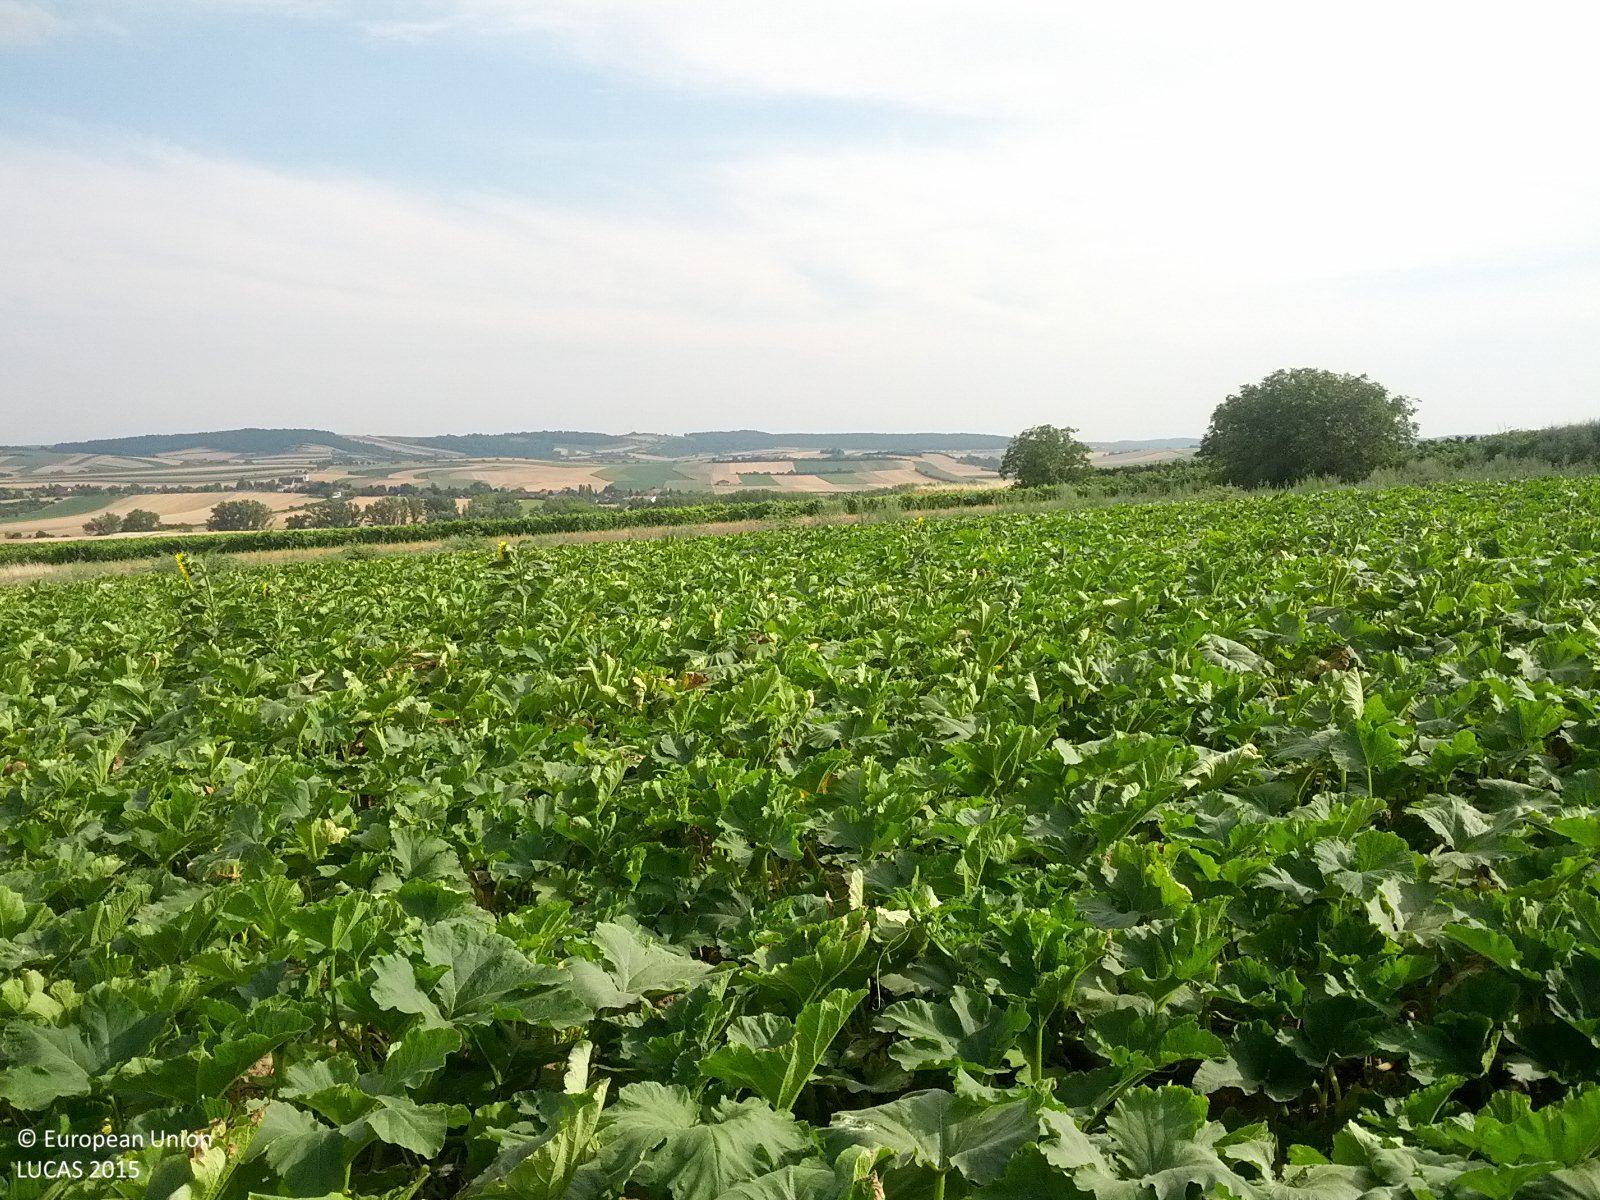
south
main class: Cropland
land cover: Maize
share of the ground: > 75 %
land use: Agriculture (excluding fallow land and kitchen gardens)
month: July
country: AT
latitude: 48.6456
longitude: 16.1806
